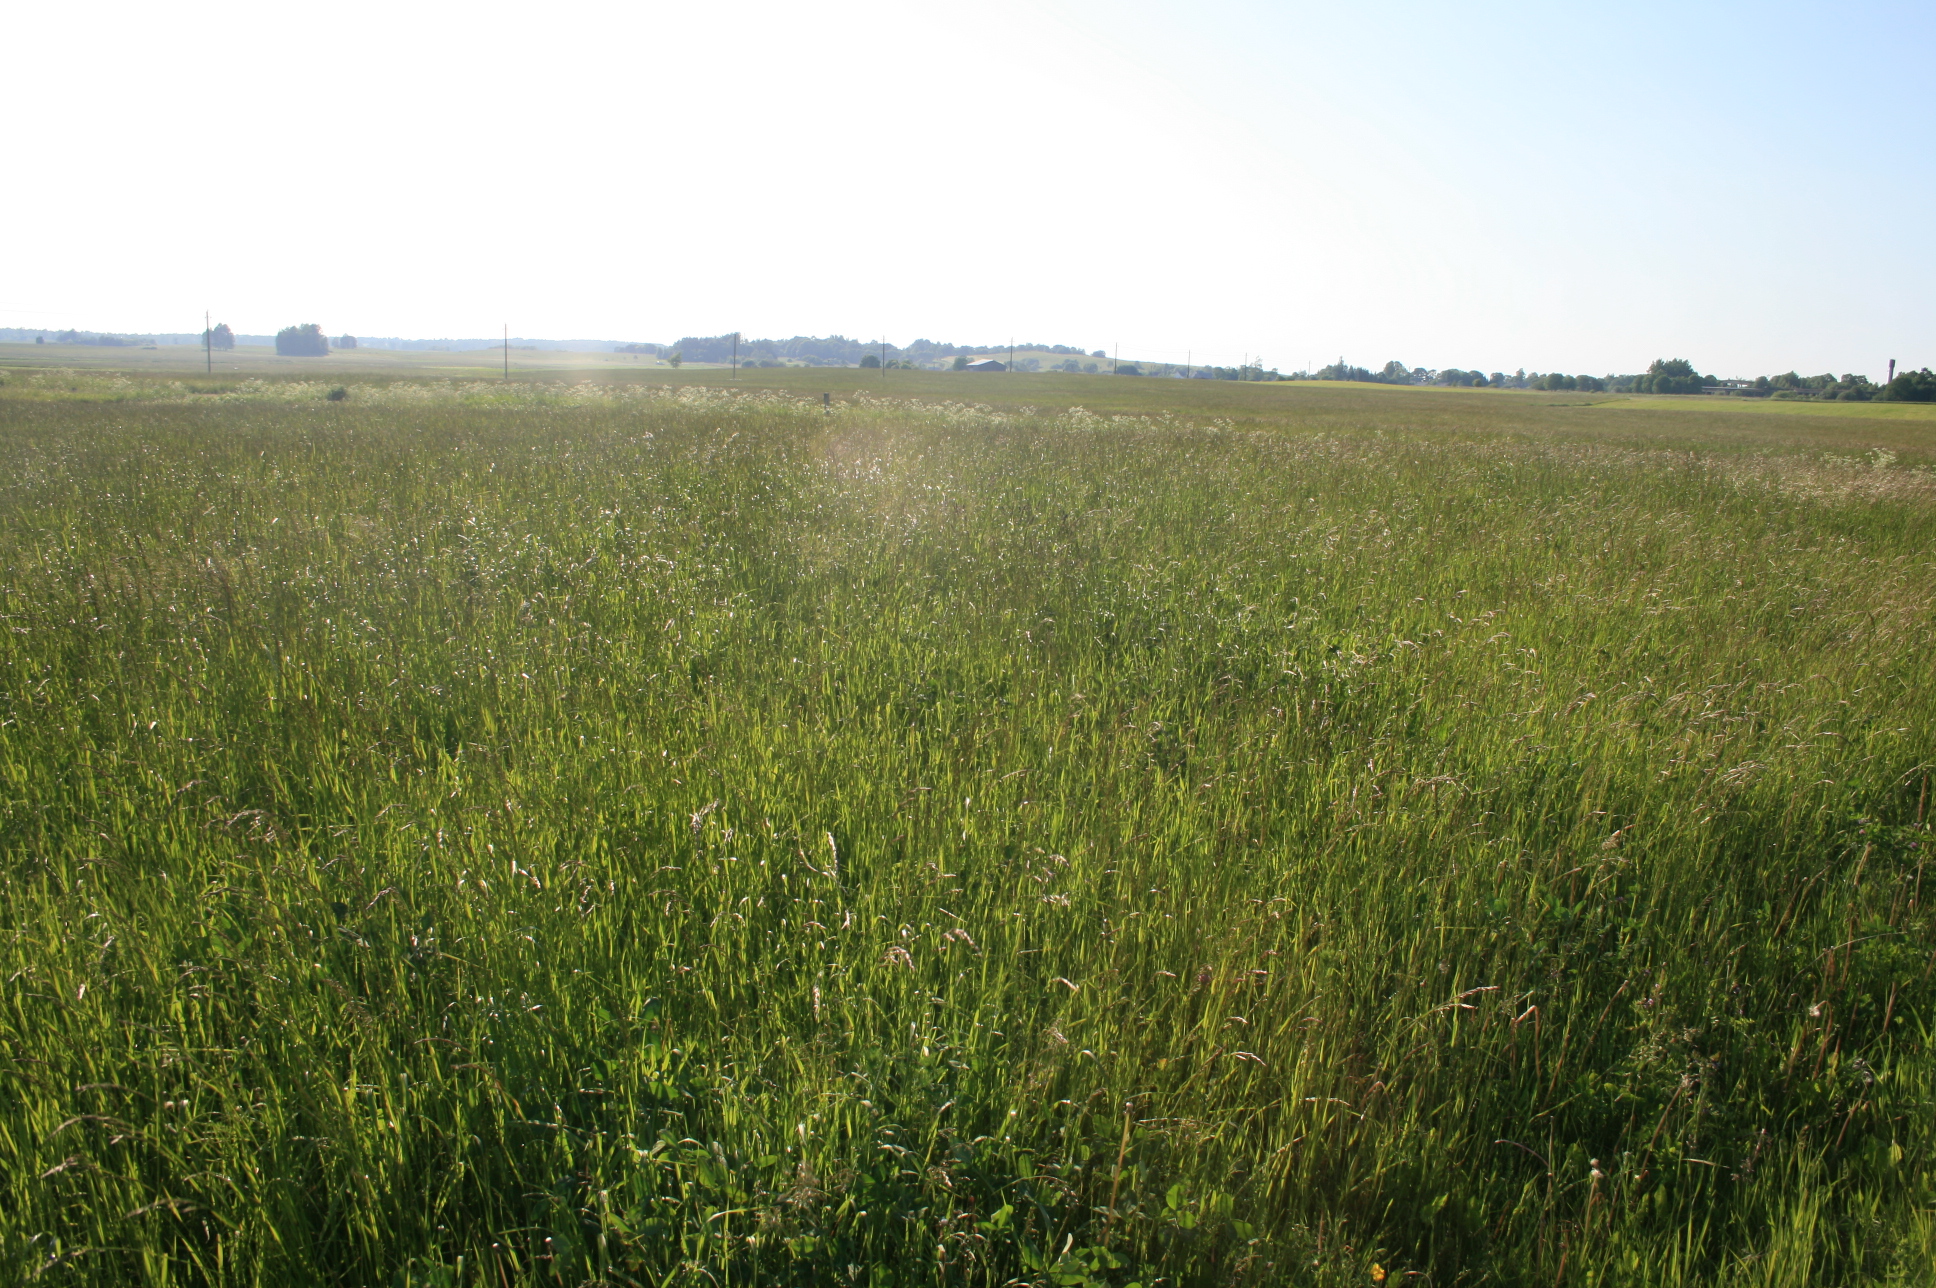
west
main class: Grassland
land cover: Grassland without tree/shrub cover
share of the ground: > 75 %
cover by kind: herbaceous plants 100 %
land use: Agriculture (excluding fallow land and kitchen gardens)
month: June
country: LT
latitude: 55.6562
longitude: 22.2146
